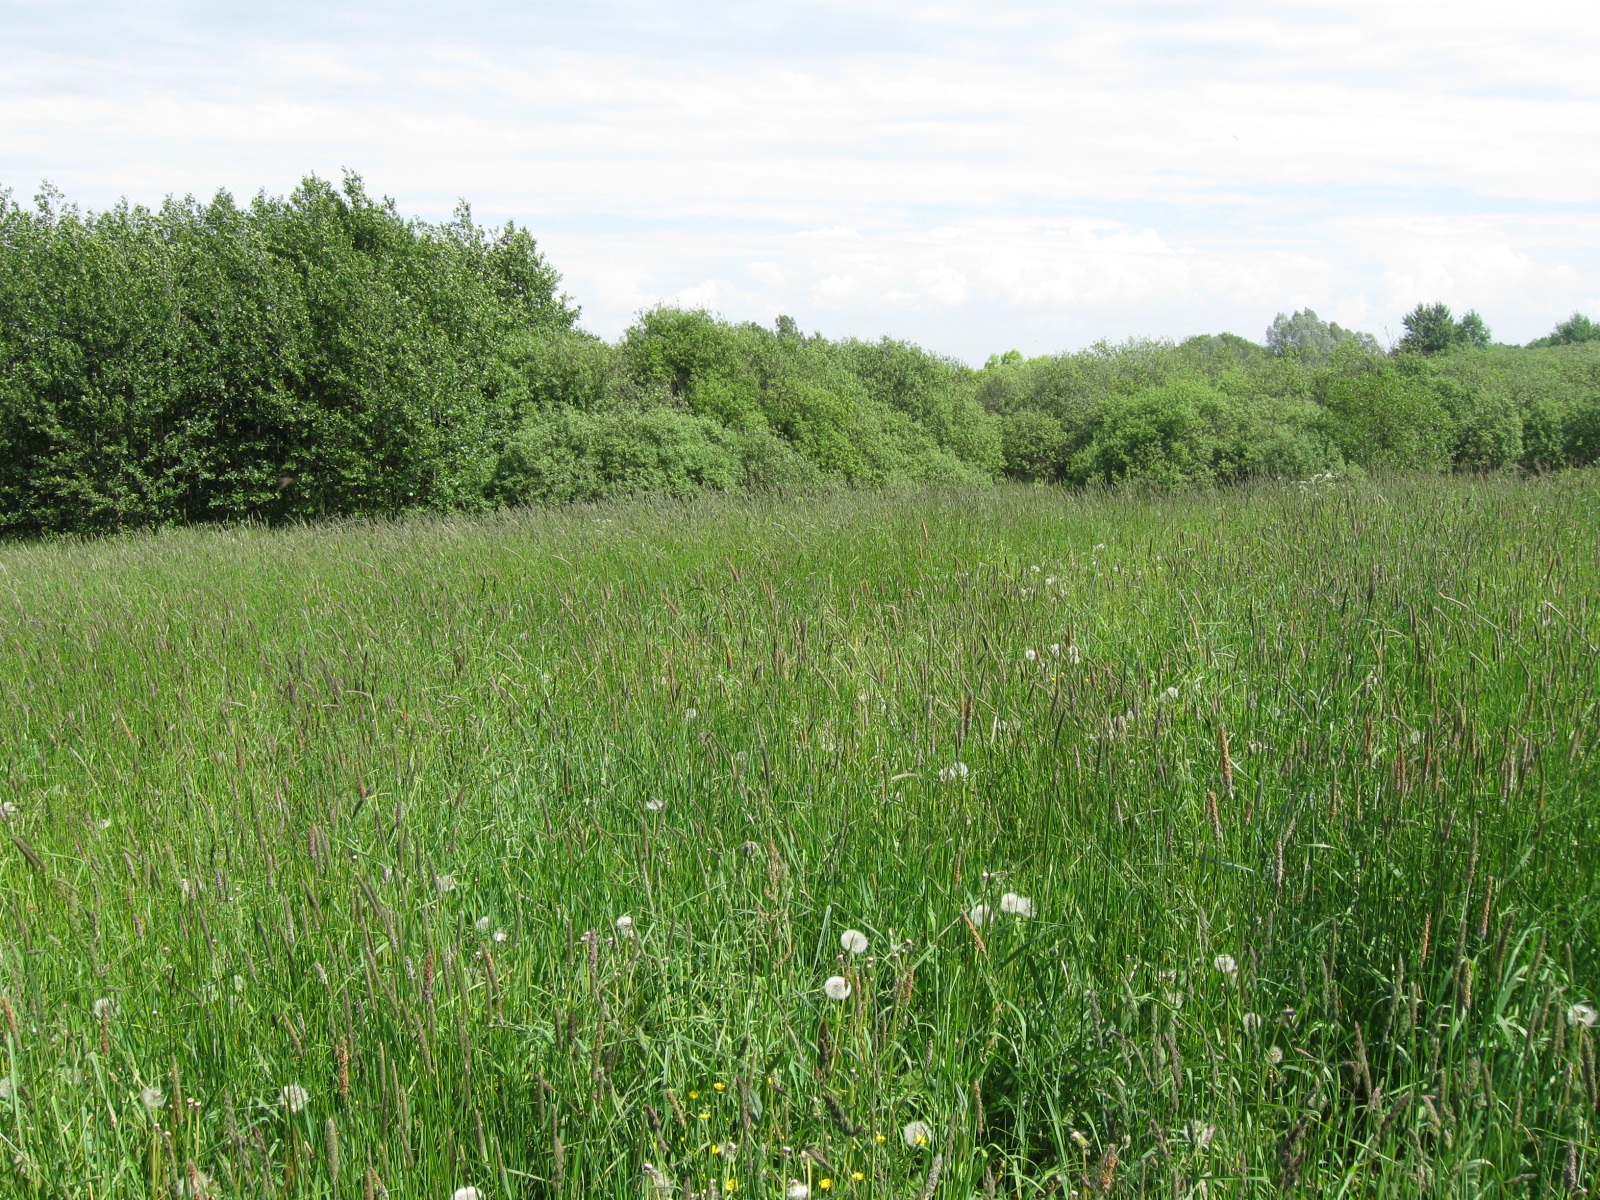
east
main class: Grassland
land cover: Grassland without tree/shrub cover
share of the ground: > 75 %
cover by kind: herbaceous plants 100 %
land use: Agriculture (excluding fallow land and kitchen gardens)
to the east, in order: Grassland without tree/shrub cover; Broadleaved woodland; Grassland without tree/shrub cover
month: June
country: LT
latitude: 54.2330
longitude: 23.7882
